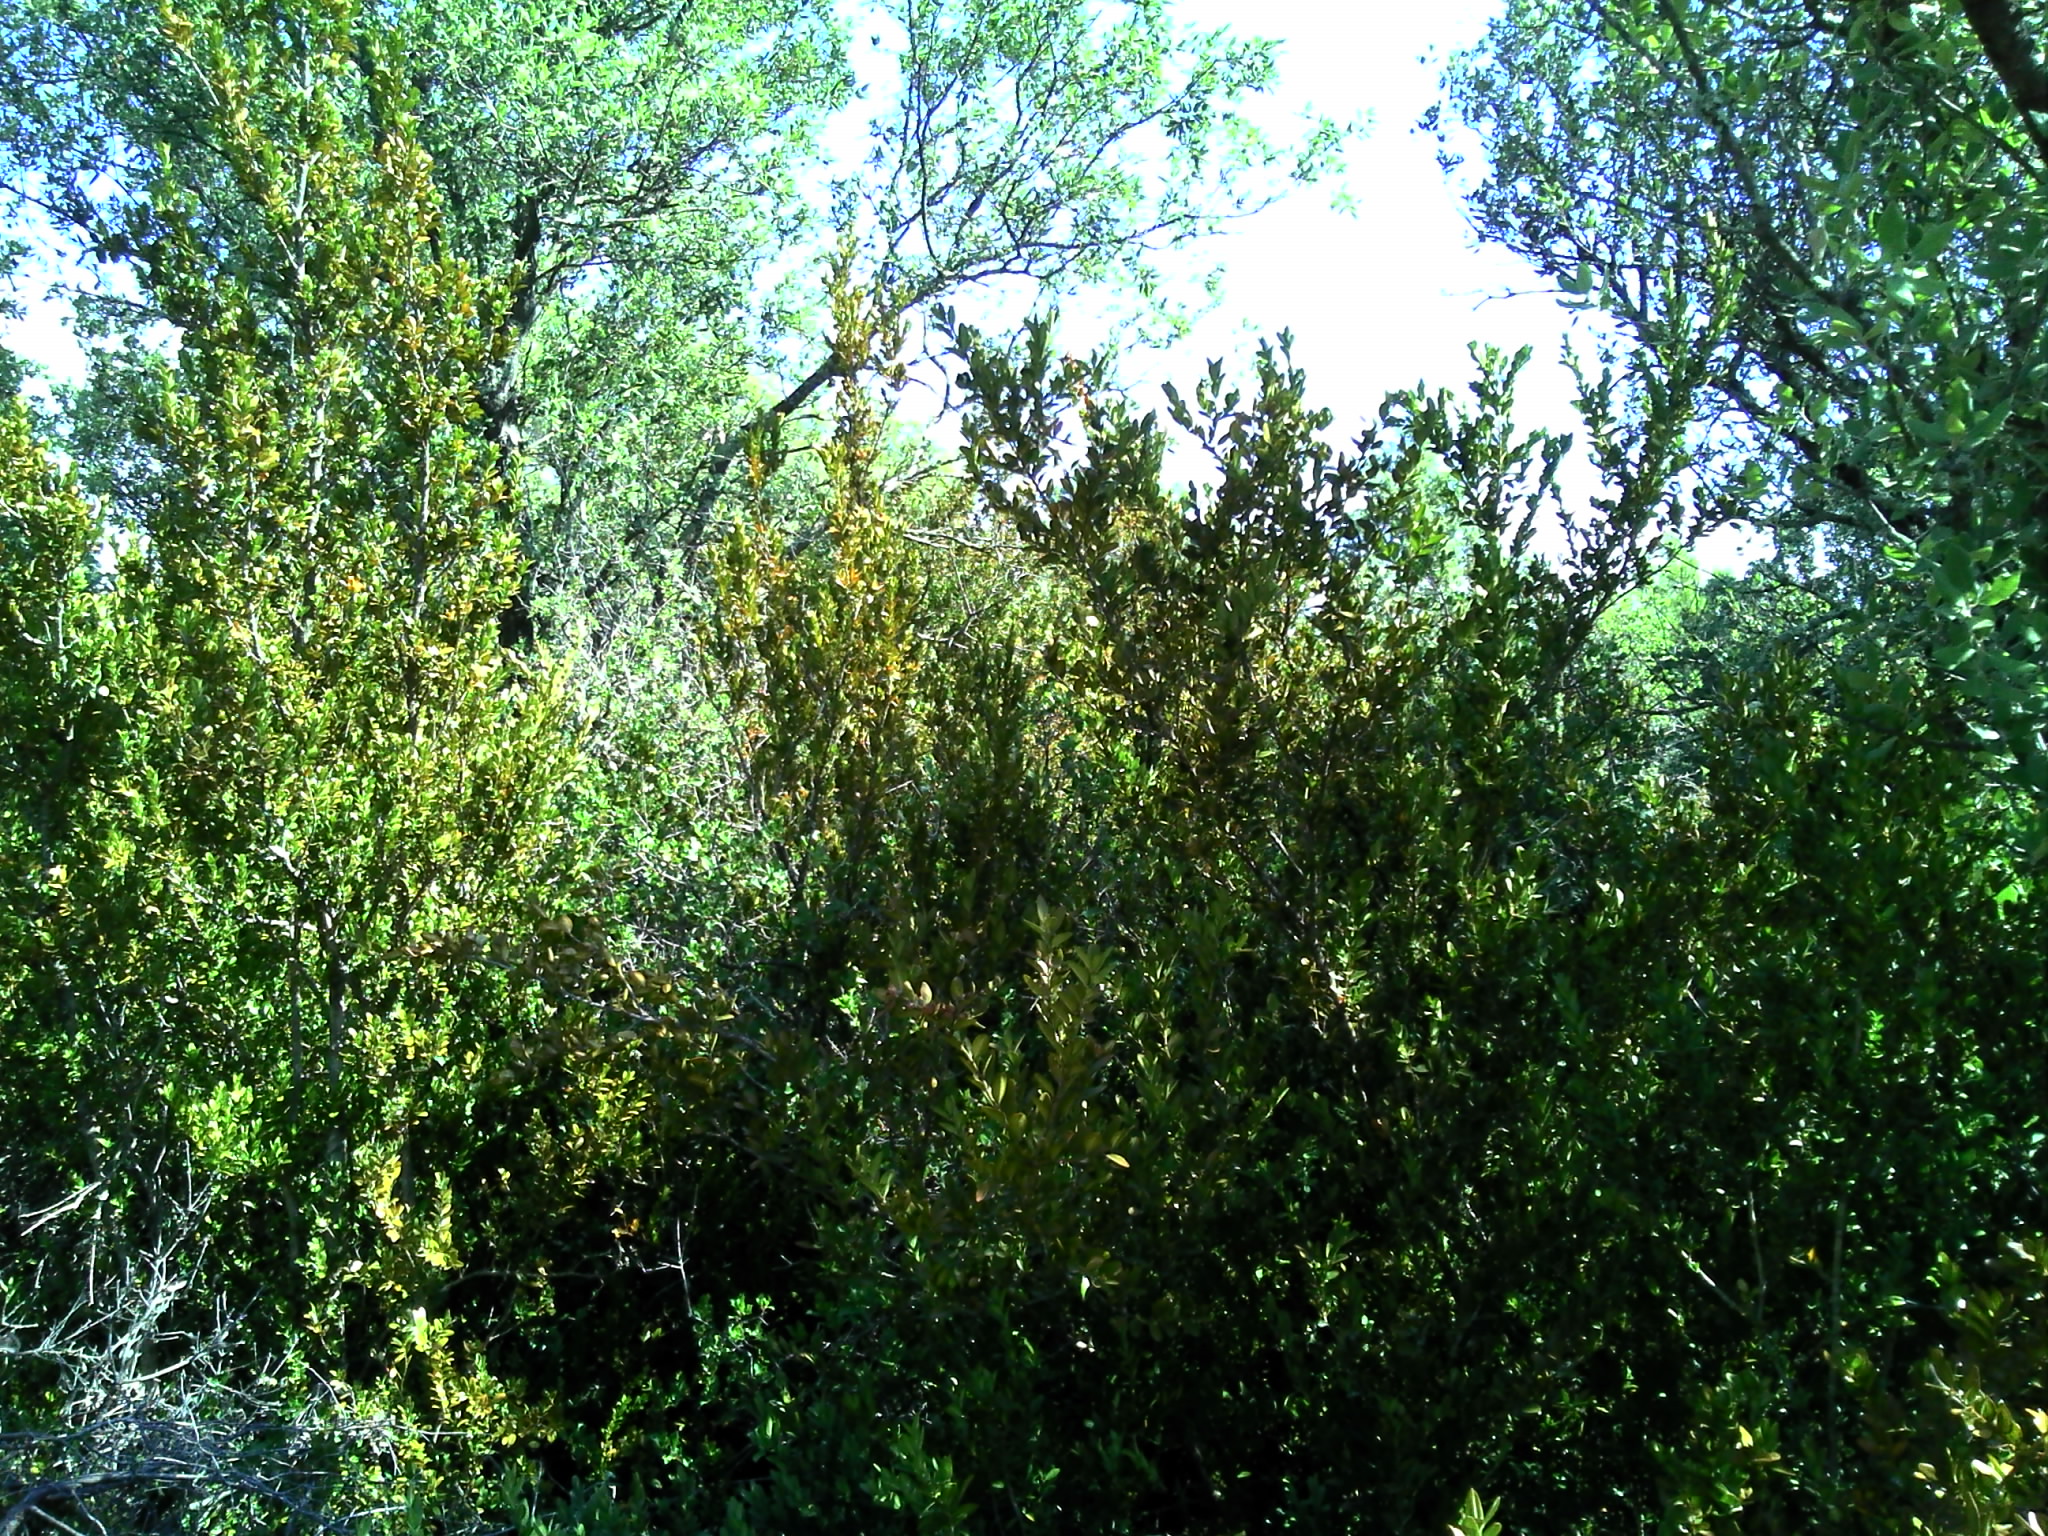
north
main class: Woodland
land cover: Broadleaved woodland
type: broadleaved evergreen forest
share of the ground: > 75 %
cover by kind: broadleaved forest trees 60 %, shrubs 20 %, herbaceous plants 10 %, consolidated bare surface 10 %
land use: Semi-natural and natural areas not in use
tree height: > 5 m
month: July
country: FR
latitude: 44.0495
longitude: 4.3041
